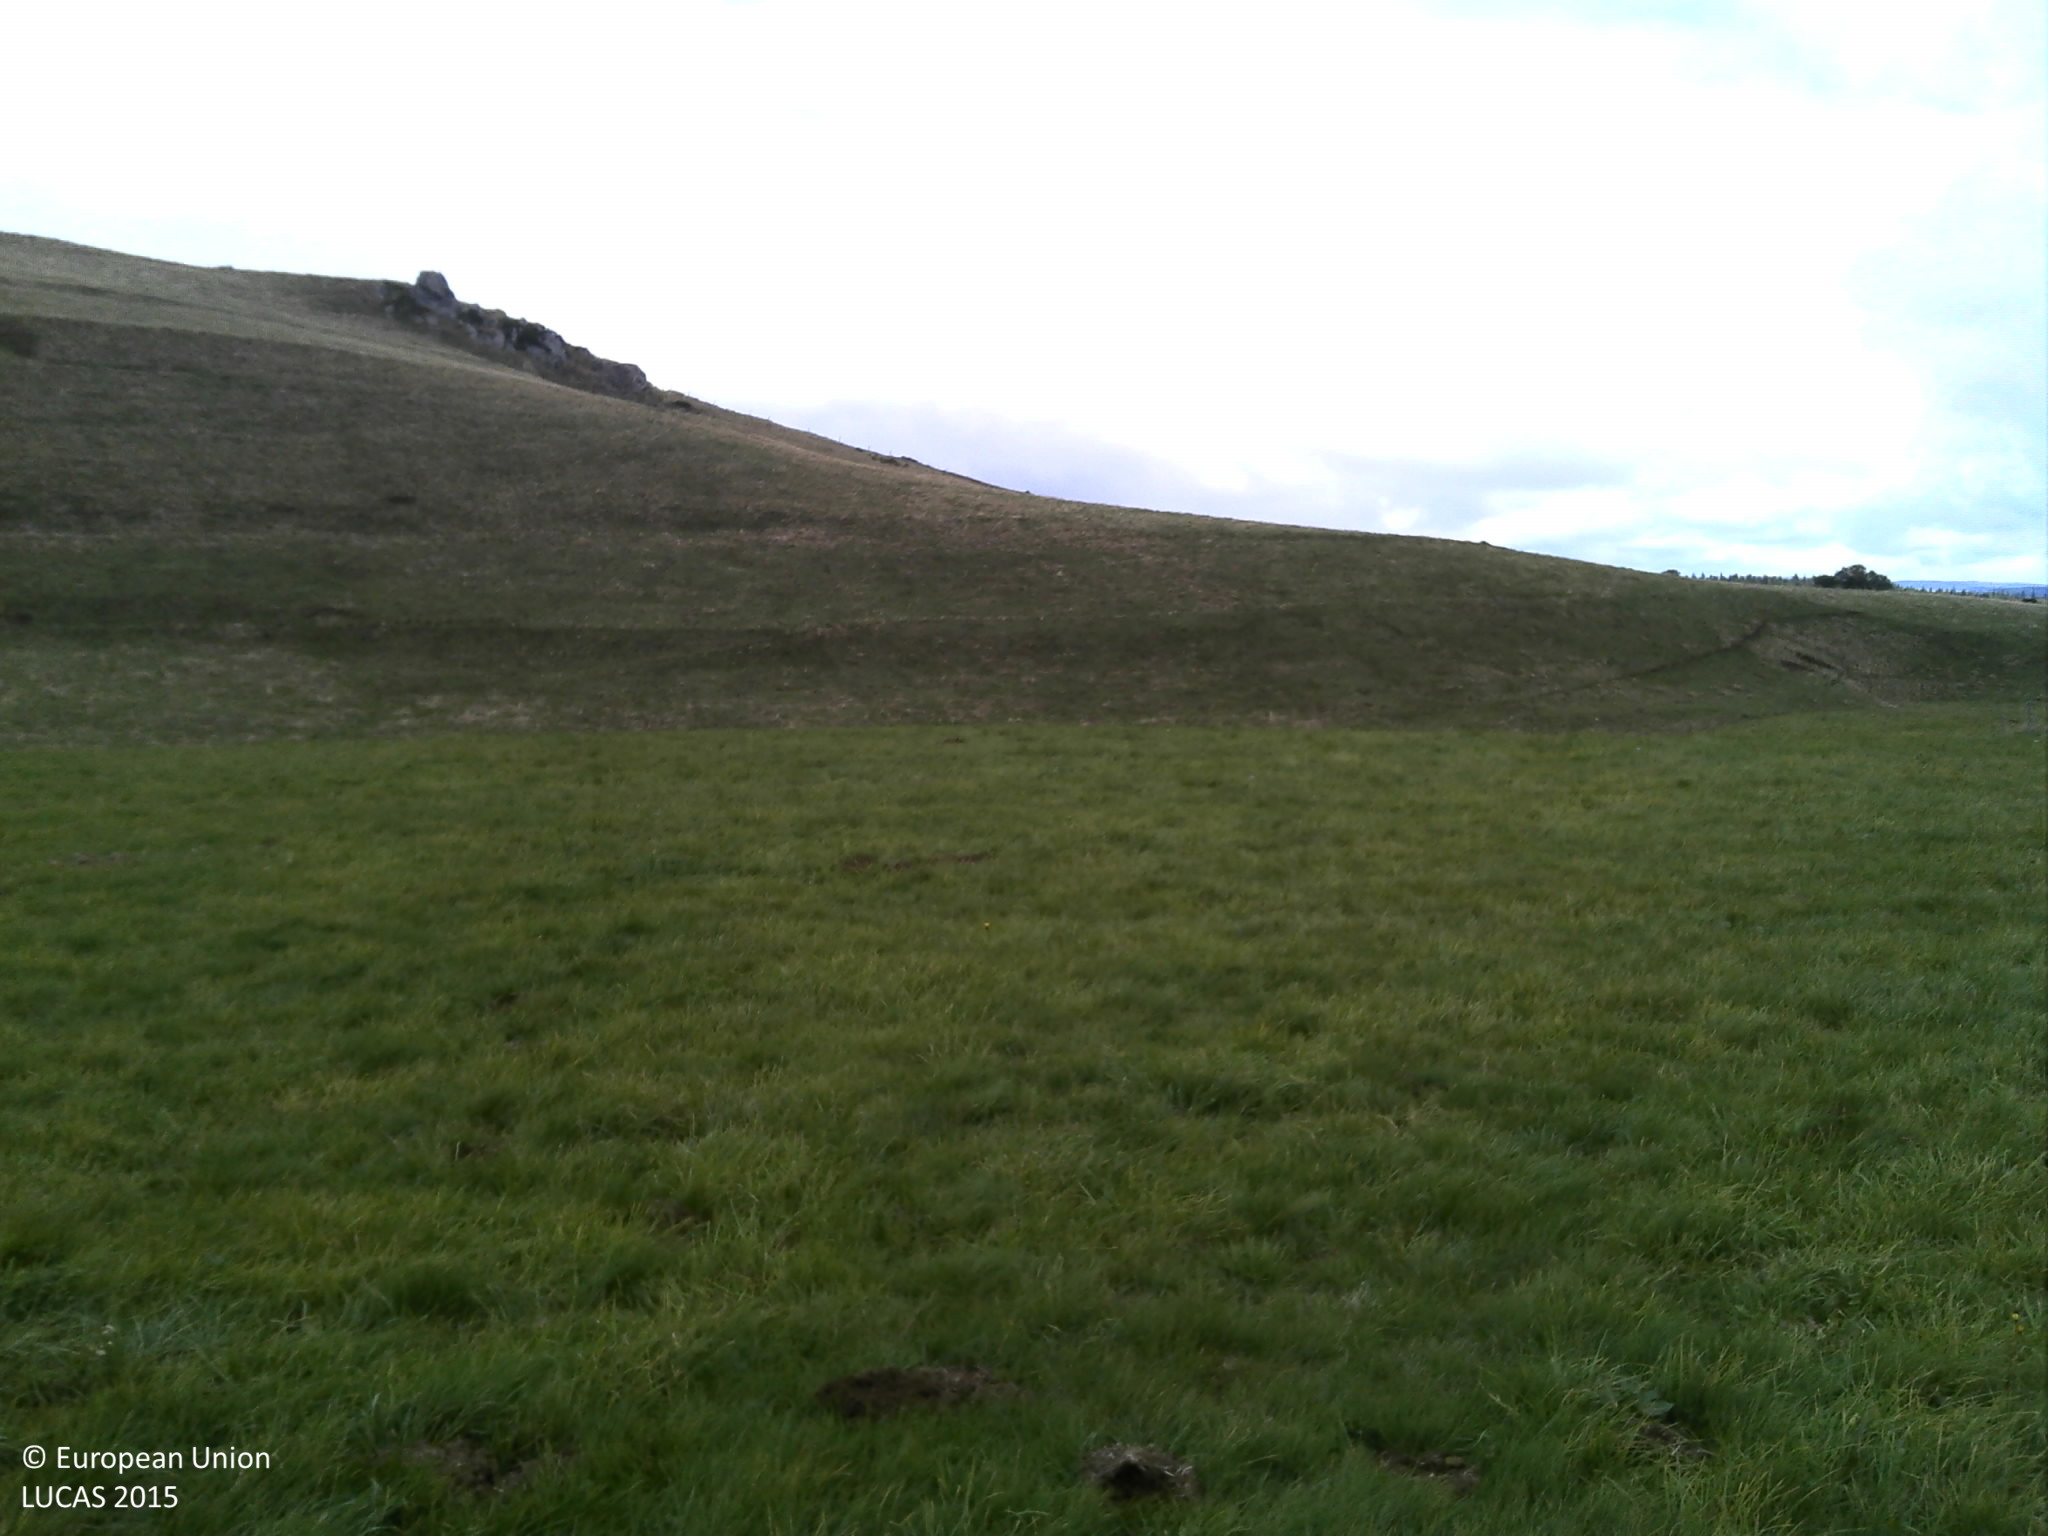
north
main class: Grassland
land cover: Grassland without tree/shrub cover
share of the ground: > 75 %
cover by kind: herbaceous plants 100 %
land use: Agriculture (excluding fallow land and kitchen gardens)
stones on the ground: < 10 %
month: September
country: FR
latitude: 45.5181
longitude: 2.8949
